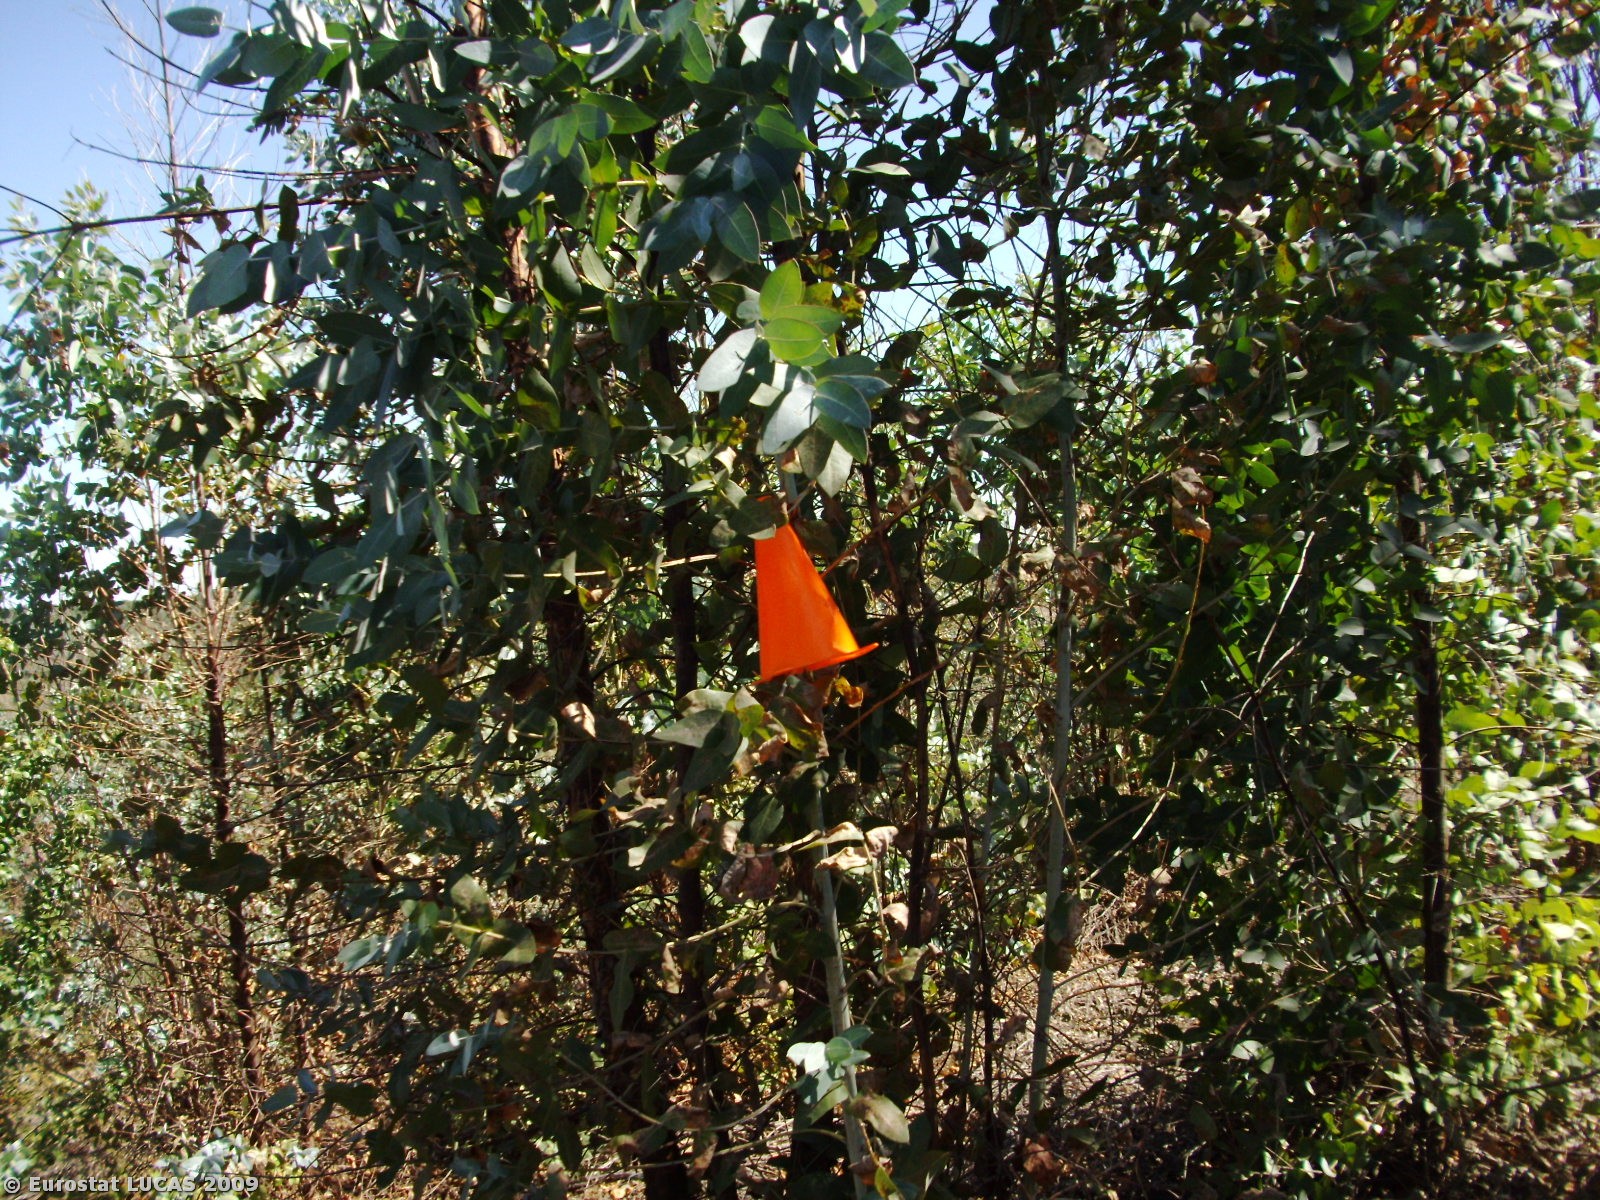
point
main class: Woodland
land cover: Broadleaved woodland
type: plantations and self-sown exotic forest
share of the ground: > 75 %
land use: Forestry
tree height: > 5 m
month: June
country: PT
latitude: 40.0416
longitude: -7.2198
